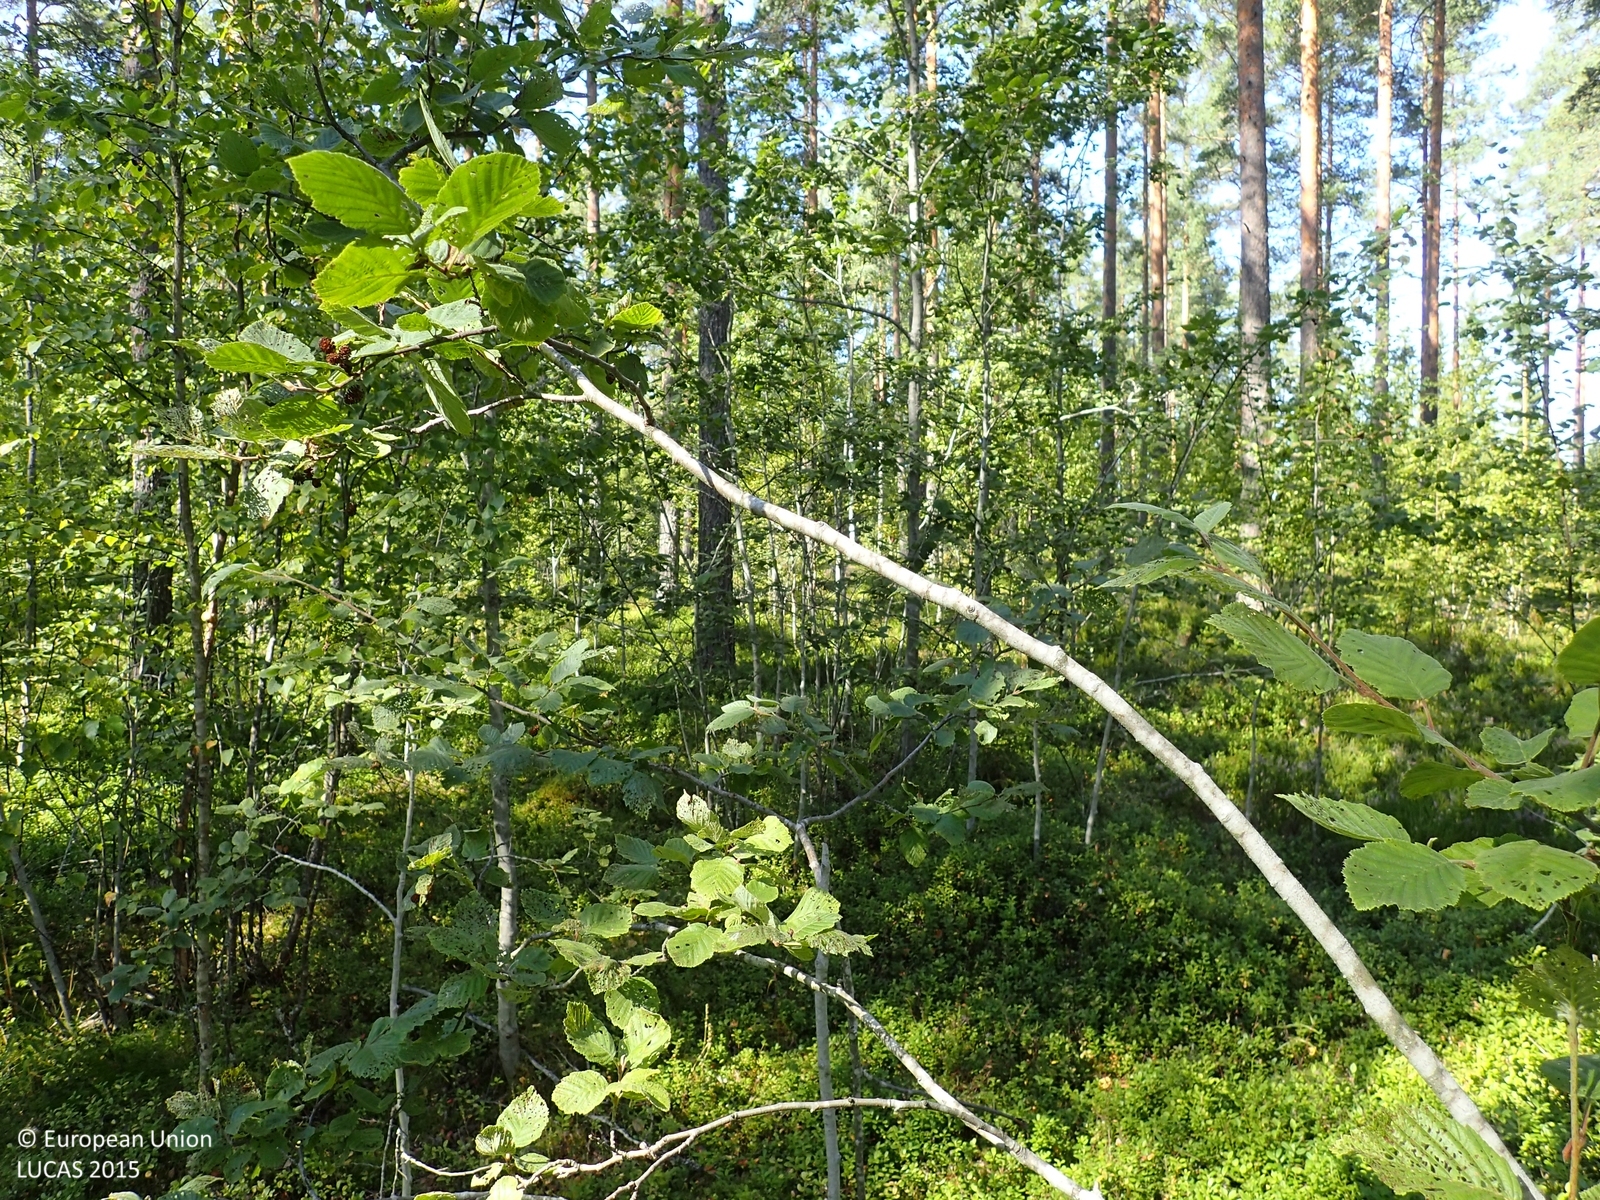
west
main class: Woodland
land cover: Pine dominated mixed woodland
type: boreal forest
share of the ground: 50 - 75 %
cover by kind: coniferous forest trees 45 %, shrubs 40 %, broadleaved forest trees 15 %
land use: Forestry
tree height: > 5 m
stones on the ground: < 10 %
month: August
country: FI
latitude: 62.3909
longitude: 21.9446
